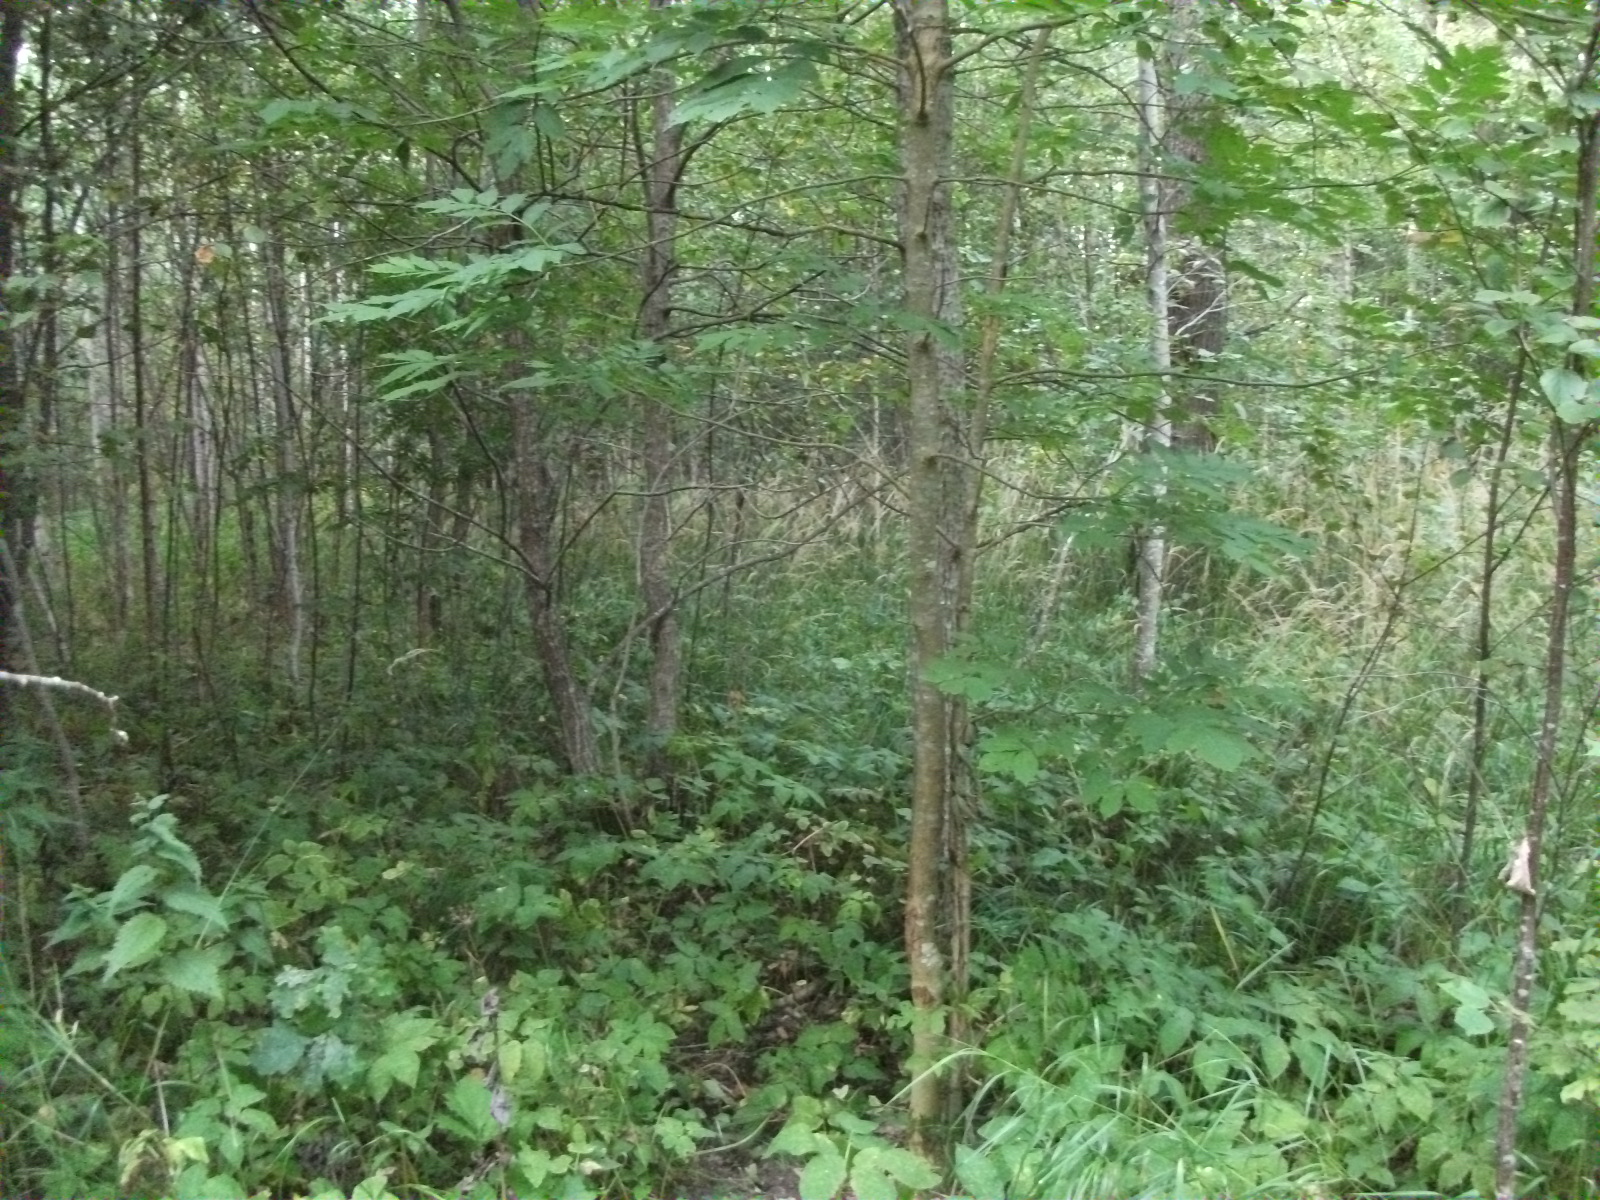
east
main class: Woodland
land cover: Broadleaved woodland
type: non-riverine alder, birch or aspen forest
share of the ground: 50 - 75 %
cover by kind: broadleaved forest trees 60 %, herbaceous plants 35 %, shrubs 5 %
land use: Forestry
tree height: > 5 m
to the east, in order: Broadleaved woodland; Spruce dominated mixed woodland; Ditches and canals; Grass margins; Paved roads, cycling and walking lanes; Abandoned hedges; Grassland without tree/shrub cover; Common wheat
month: August
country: LV
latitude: 56.3089
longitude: 26.3238
